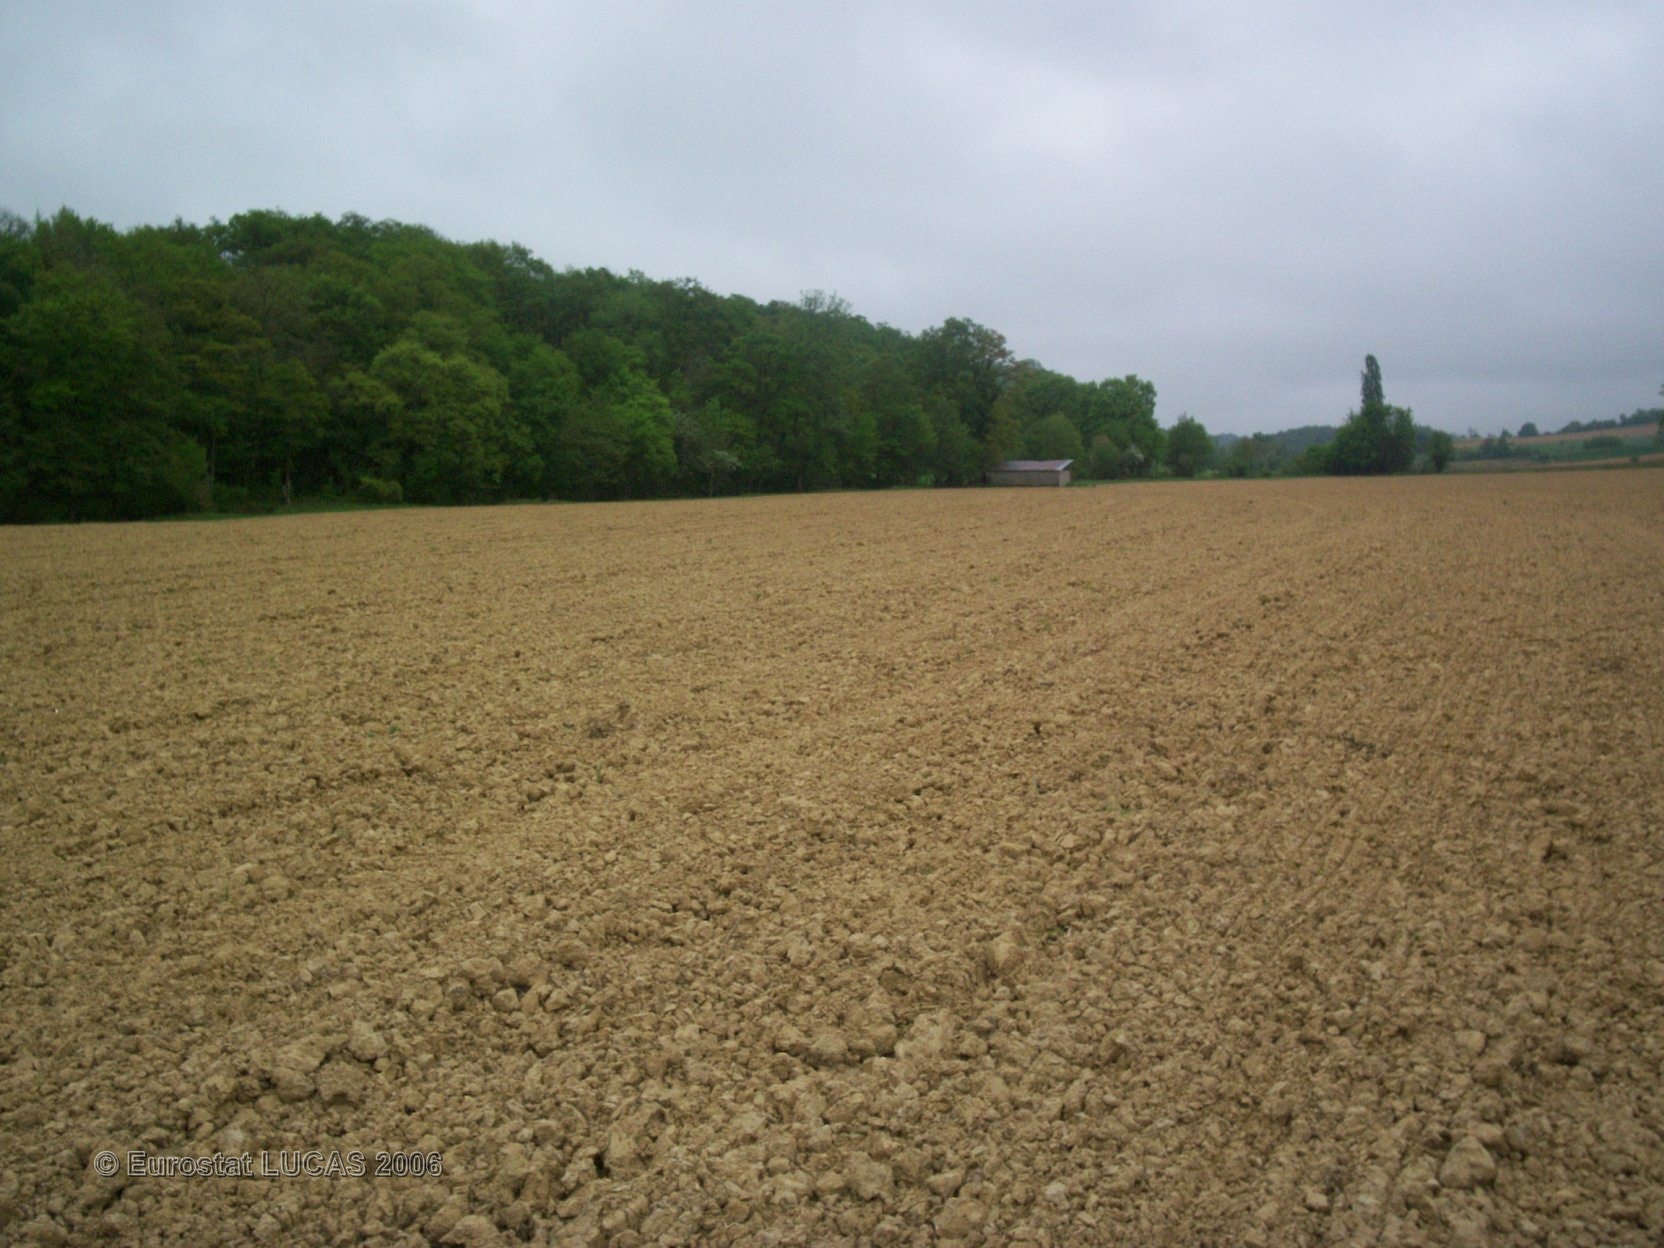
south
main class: Cropland
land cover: Maize
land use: Agriculture (excluding fallow land and kitchen gardens)
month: June
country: FR
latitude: 43.5774
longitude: -0.3486
